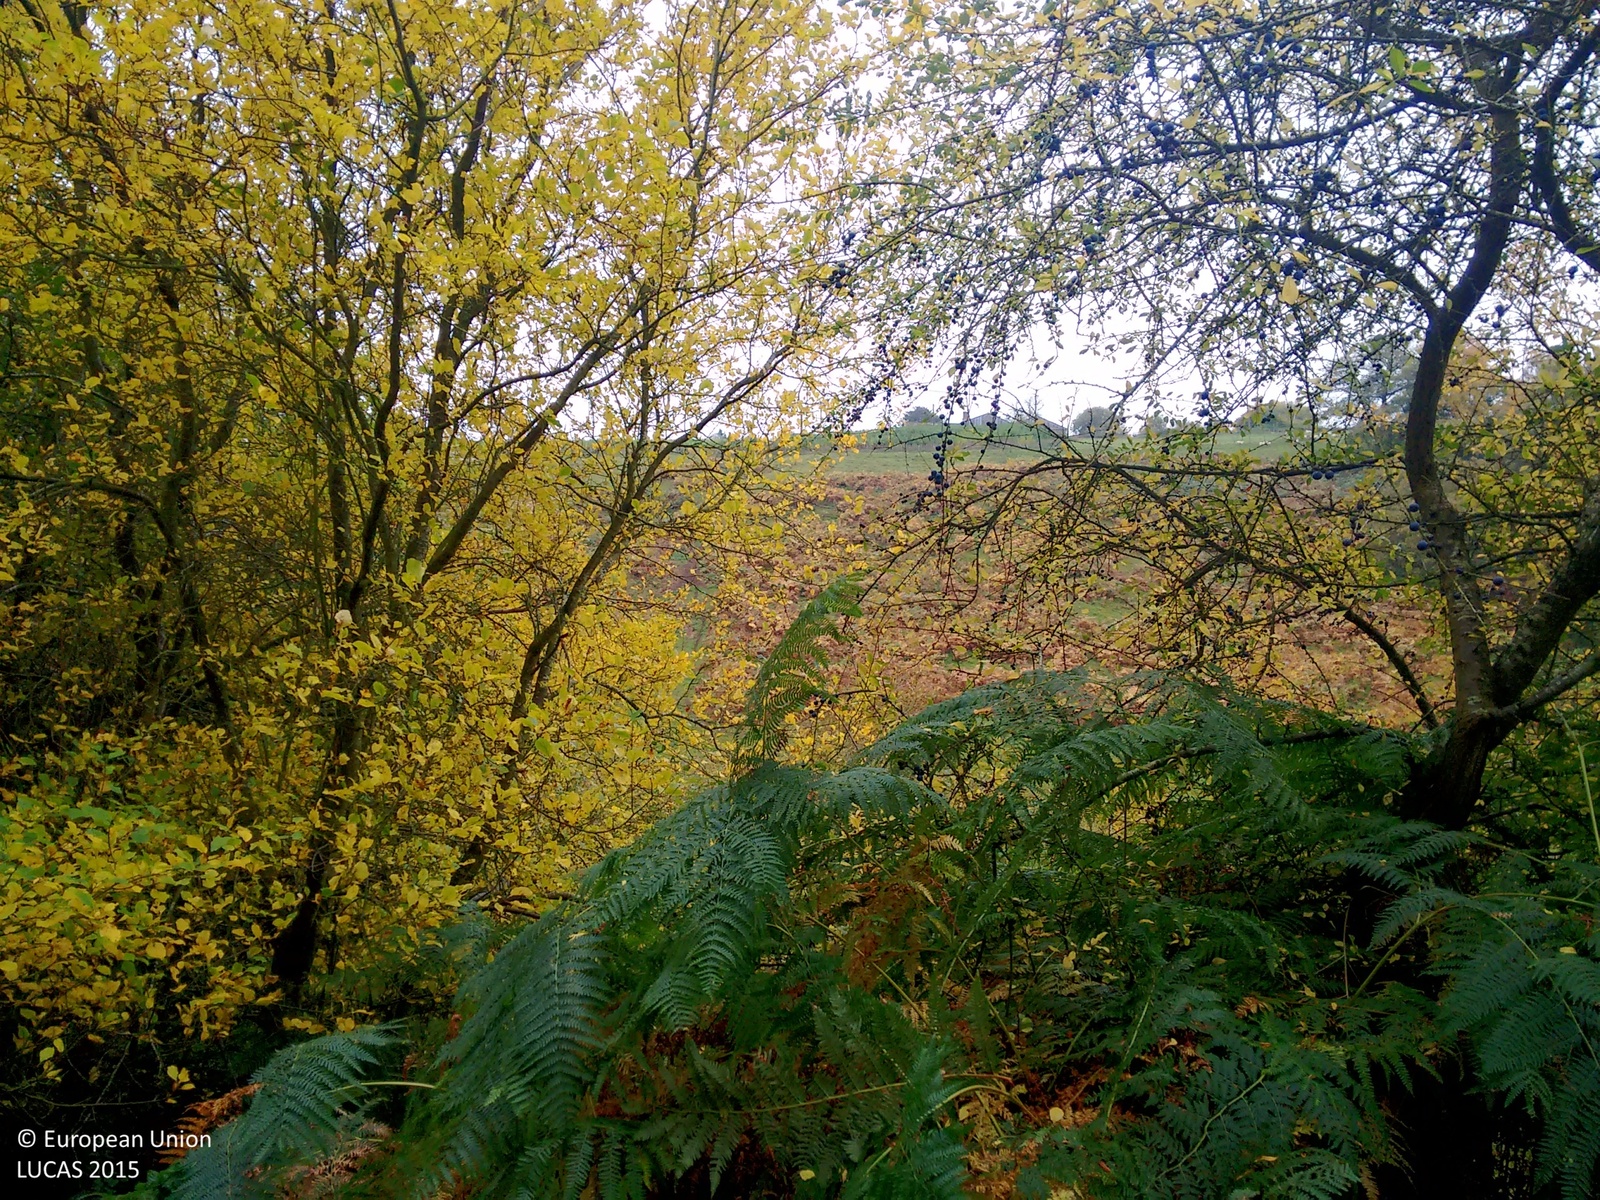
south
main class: Shrubland
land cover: Shrubland without tree cover
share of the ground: > 75 %
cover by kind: herbaceous plants 80 %, shrubs 20 %
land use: Semi-natural and natural areas not in use
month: October
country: GB
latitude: 52.4044
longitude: -2.8456
